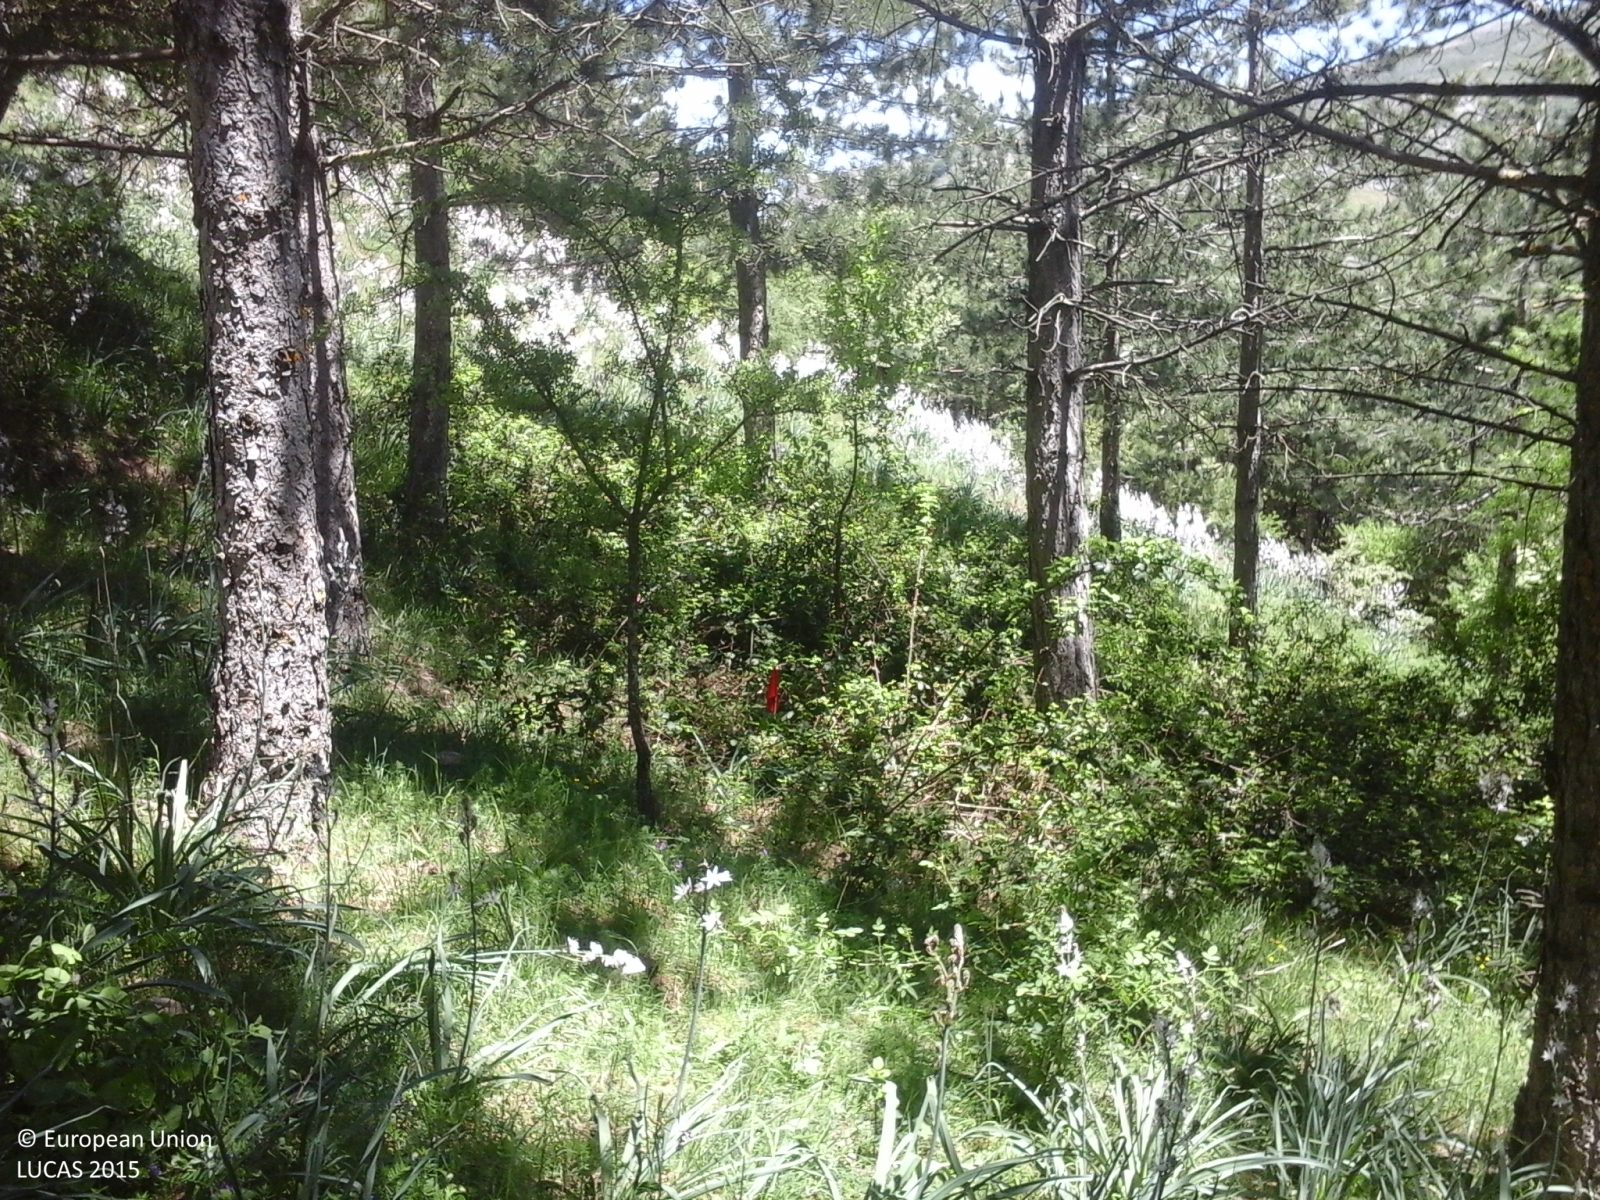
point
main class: Woodland
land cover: Pine dominated coniferous woodland
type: coniferous forest of the mediterranean region
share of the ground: > 75 %
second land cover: Grassland without tree/shrub cover
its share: > 75 %
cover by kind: coniferous forest trees 50 %, herbaceous plants 30 %, shrubs 15 %, broadleaved forest trees 5 %
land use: Forestry
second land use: Agriculture (excluding fallow land and kitchen gardens)
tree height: > 5 m
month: May
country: IT
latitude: 37.8591
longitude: 14.0969
